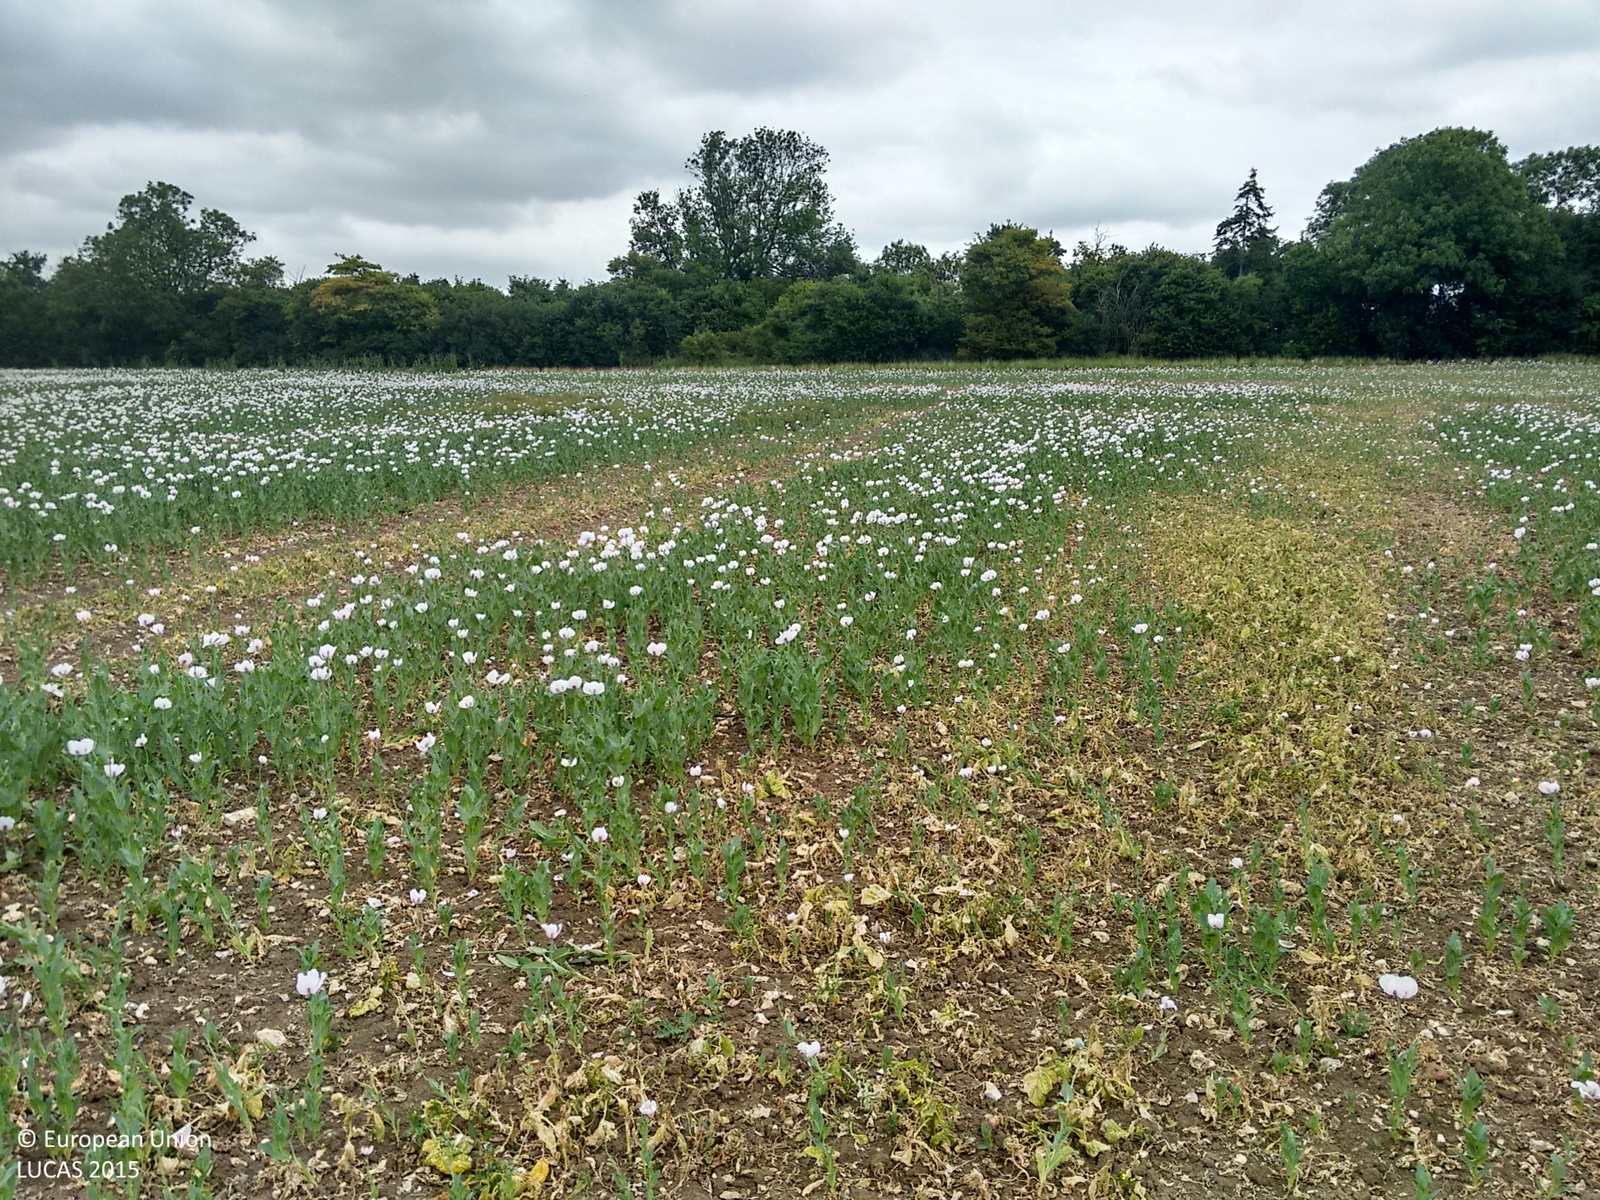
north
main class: Cropland
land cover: Other fibre and oleaginous crops
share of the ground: 25 - 50 %
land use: Agriculture (excluding fallow land and kitchen gardens)
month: July
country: GB
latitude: 51.6223
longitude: -1.0663
